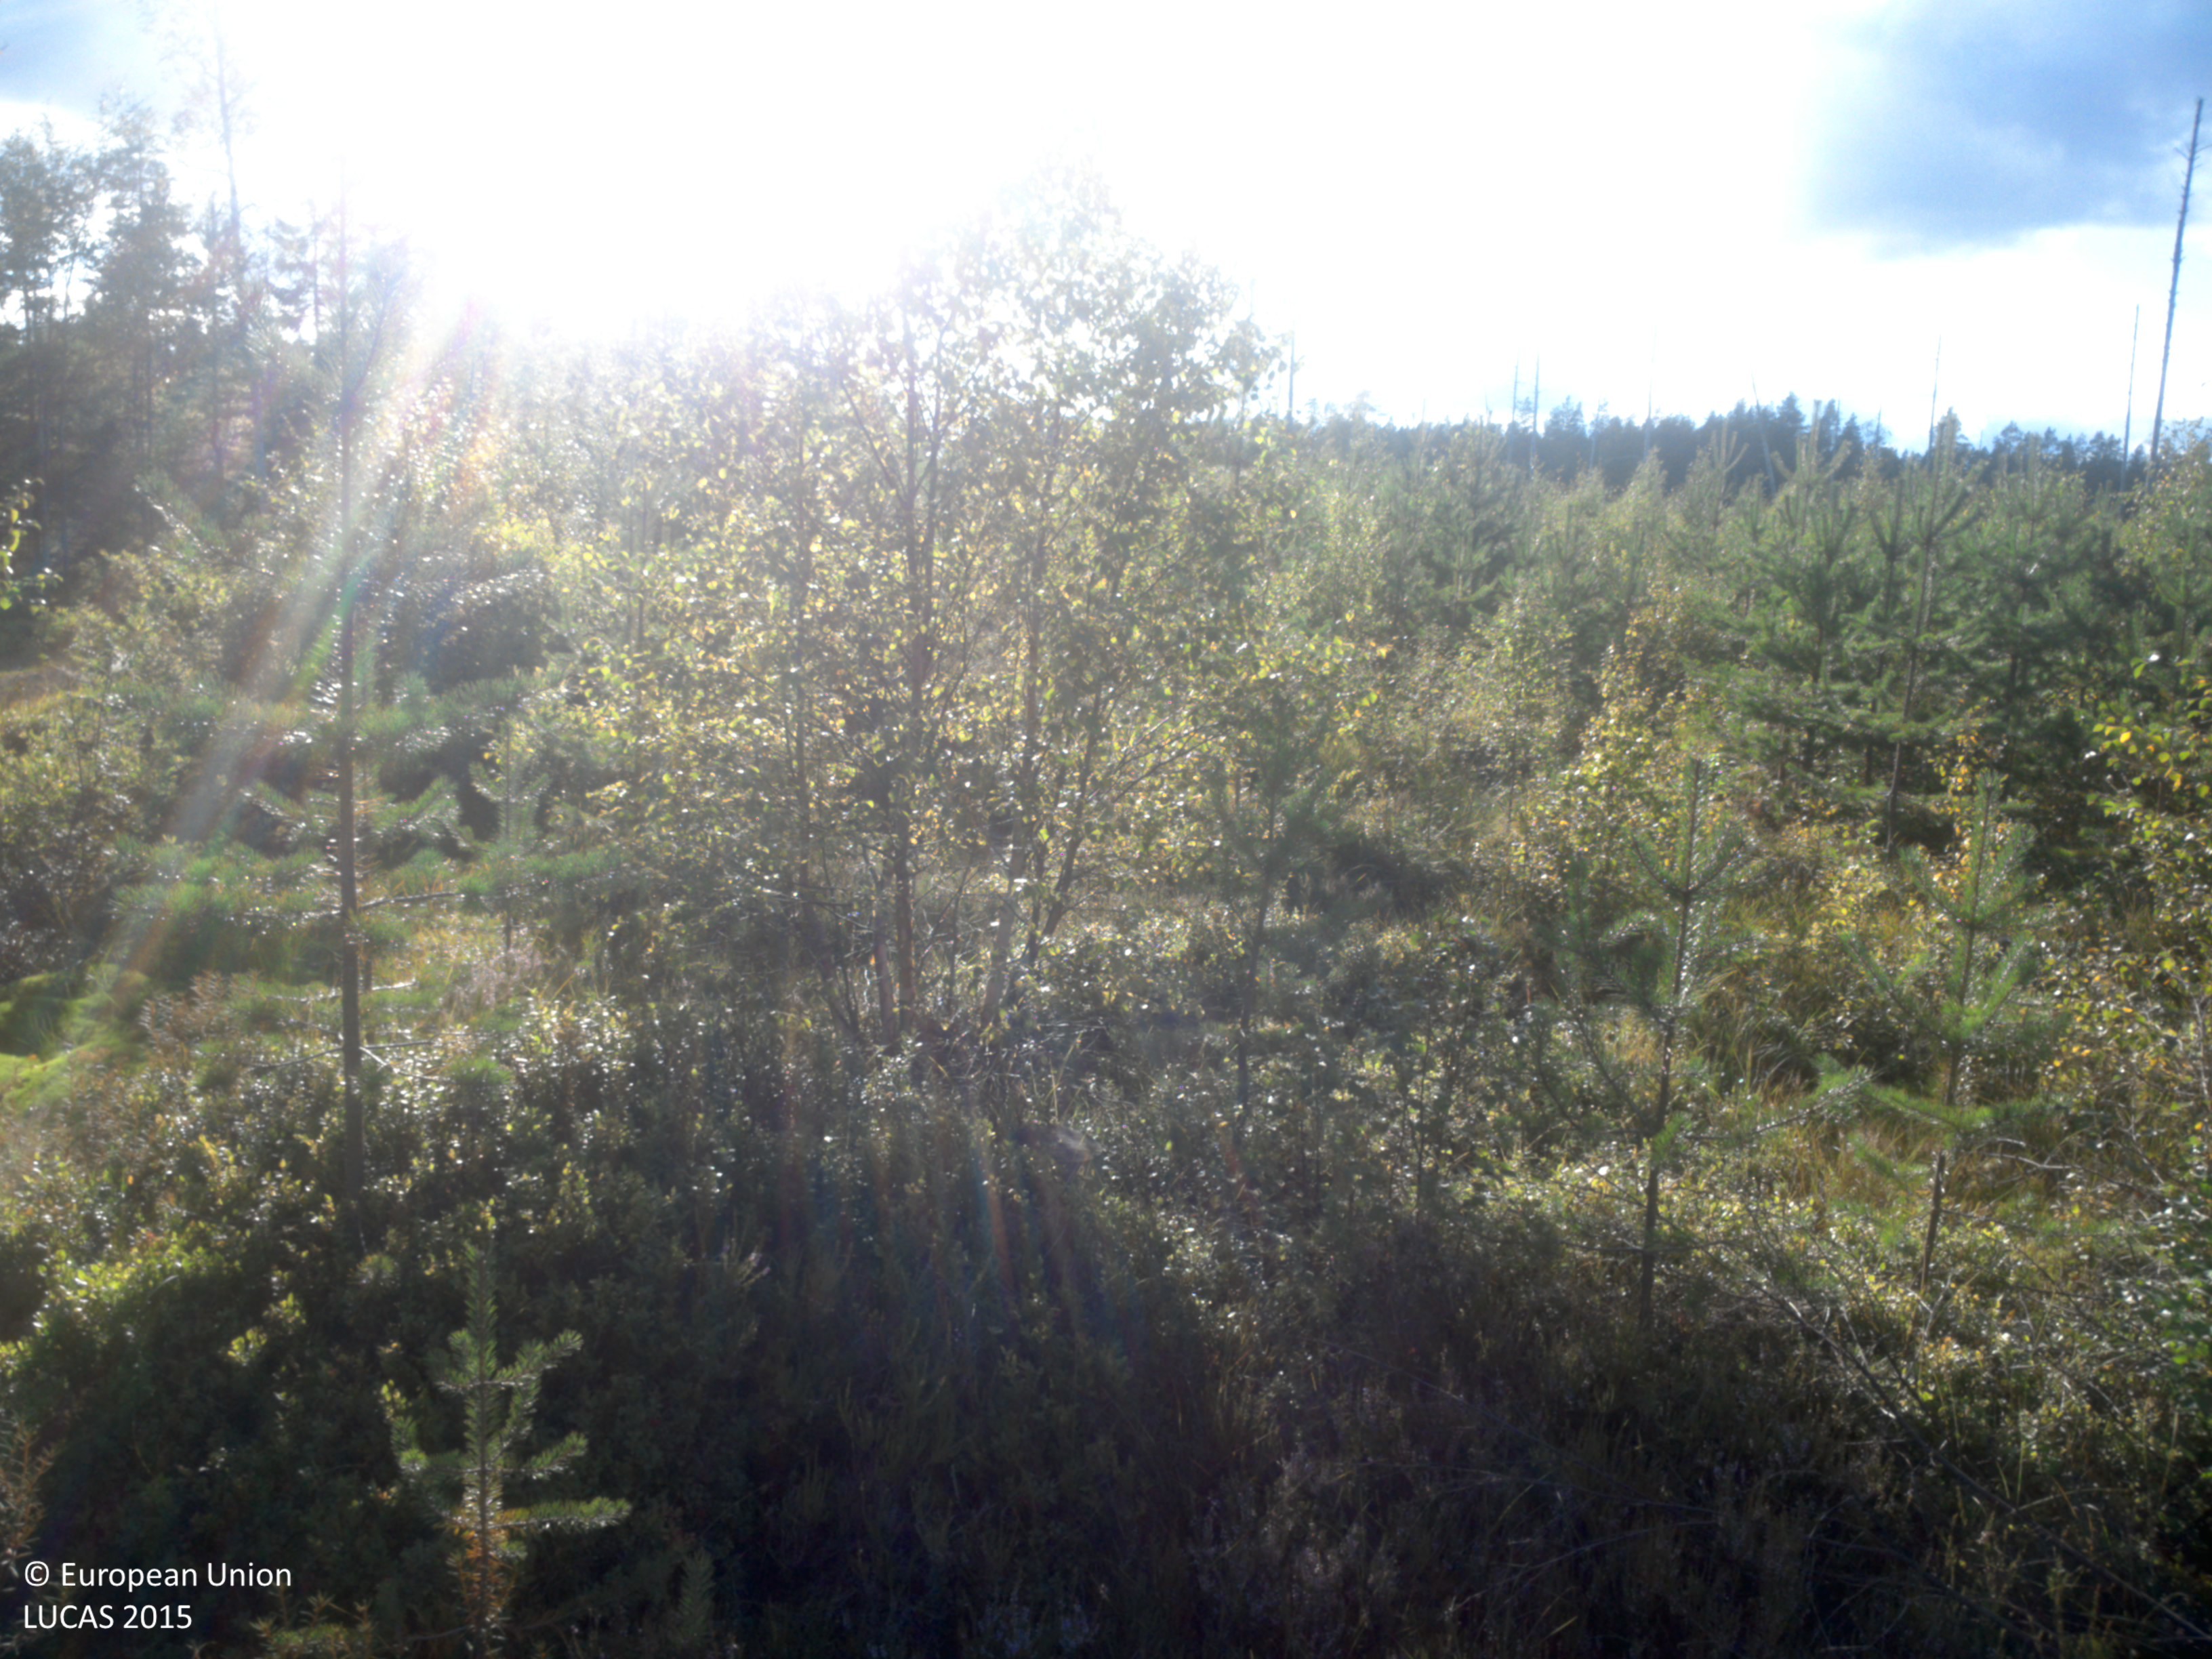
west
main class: Woodland
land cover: Other coniferous woodland
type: boreal forest
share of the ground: 50 - 75 %
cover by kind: coniferous forest trees 50 %, shrubs 50 %
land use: Forestry
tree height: > 5 m
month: August
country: SE
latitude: 63.7886
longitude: 20.0255
